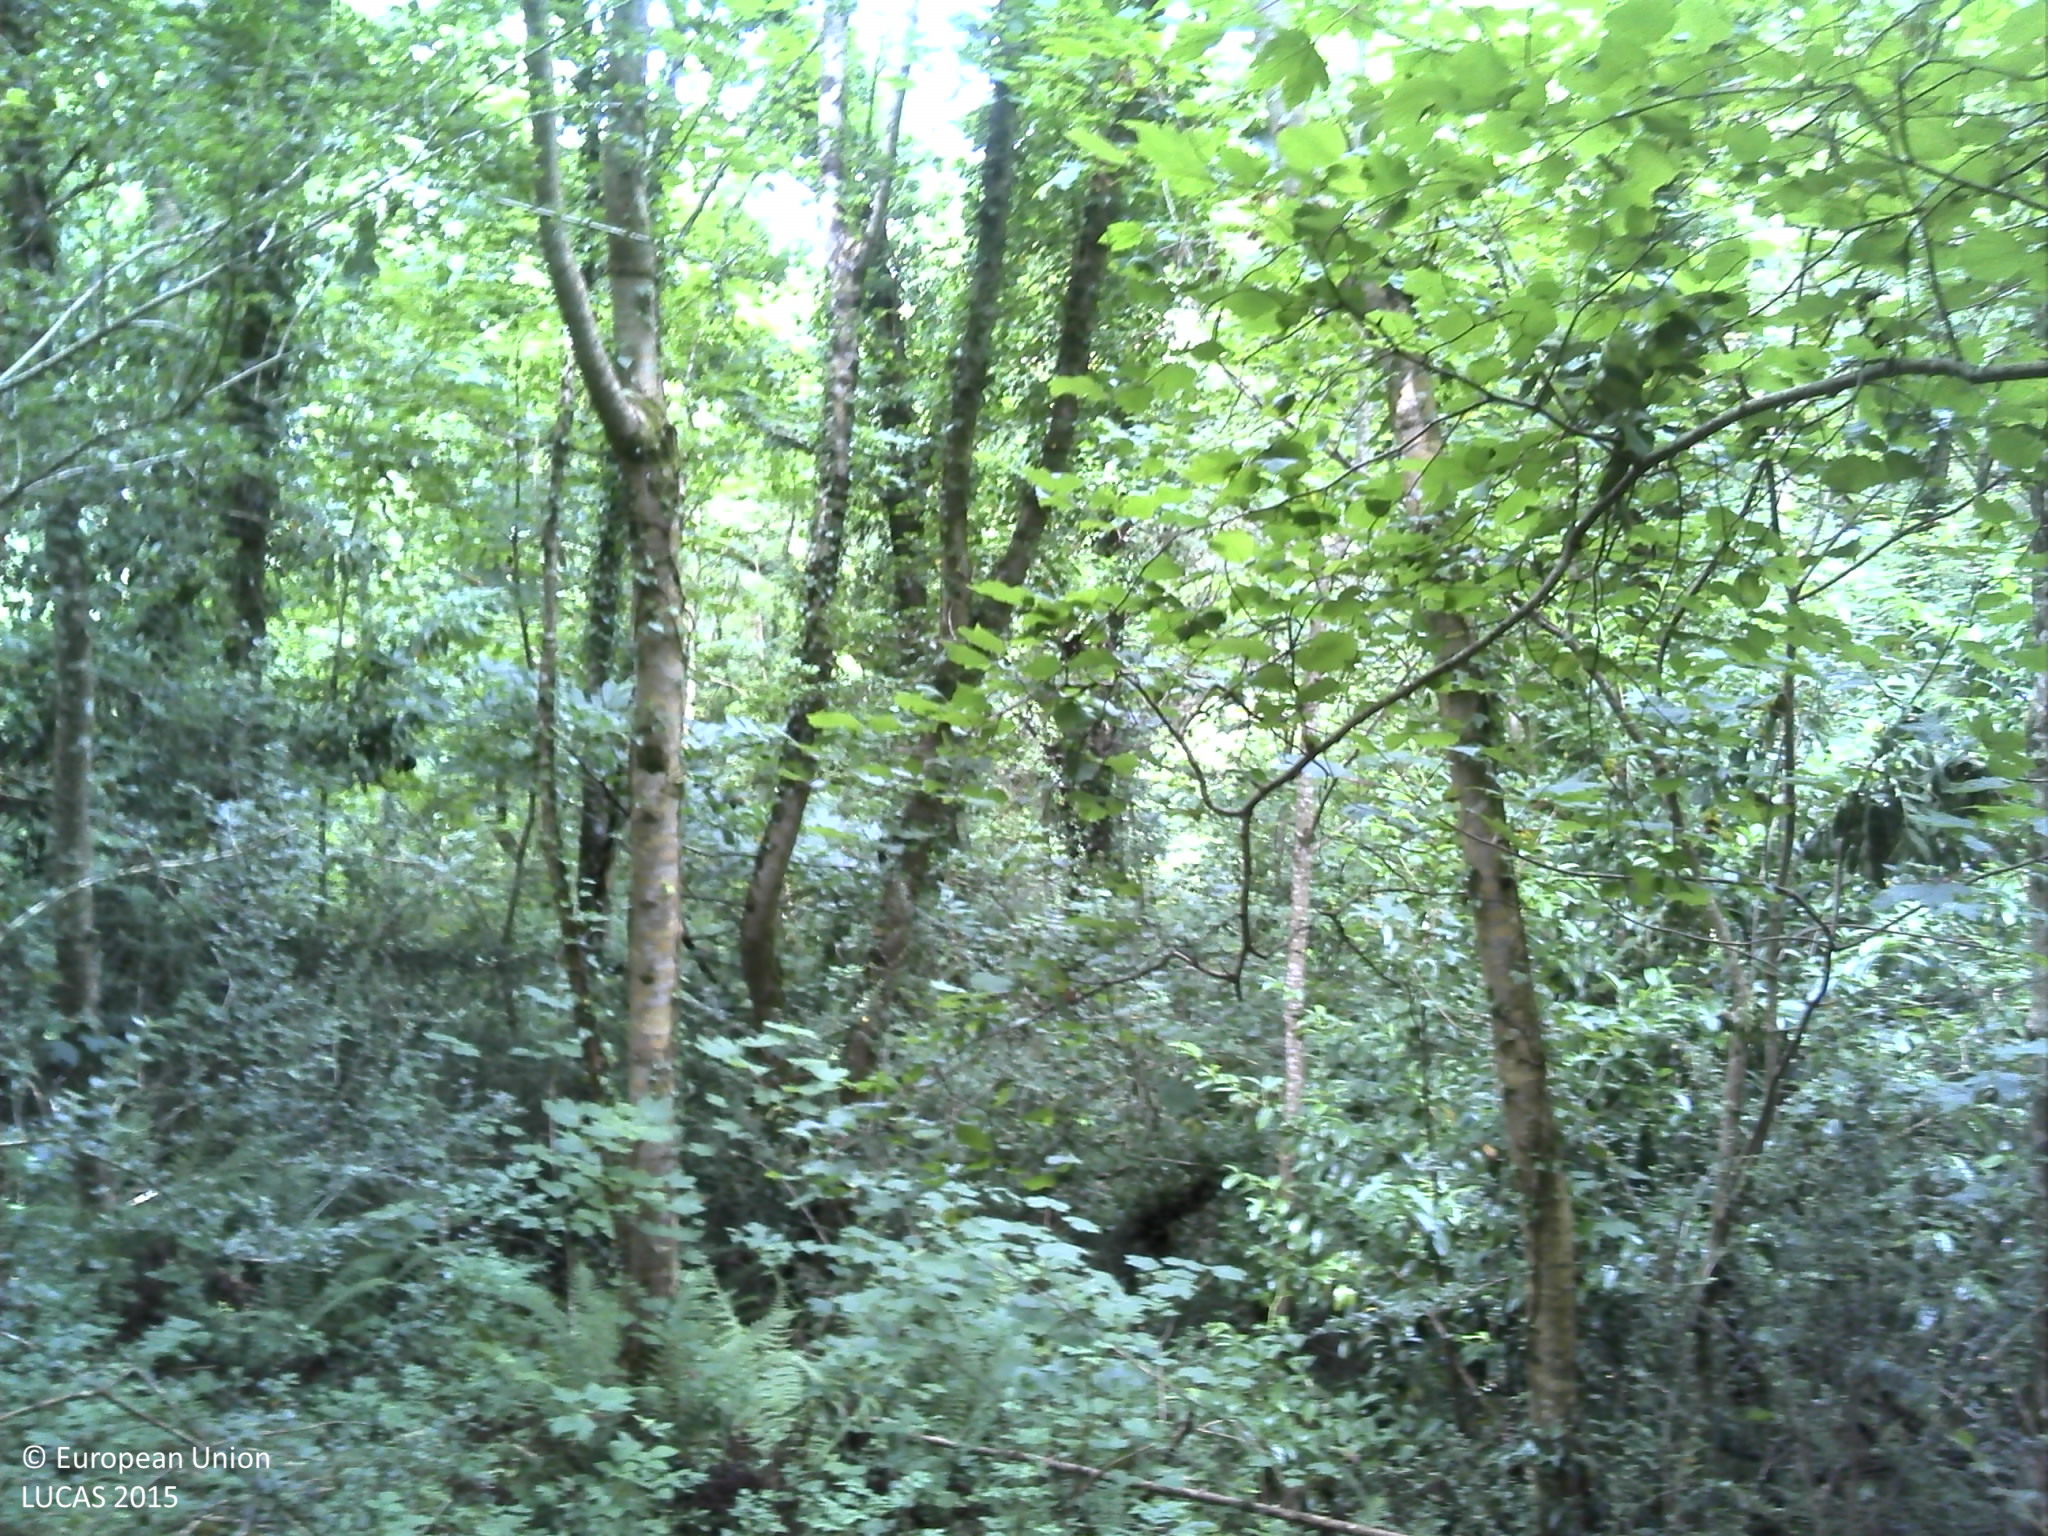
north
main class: Woodland
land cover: Broadleaved woodland
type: mesophytic deciduous forest
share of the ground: > 75 %
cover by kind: broadleaved forest trees 90 %, coniferous forest trees 5 %, shrubs 5 %
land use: Forestry
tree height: > 5 m
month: July
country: FR
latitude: 48.2777
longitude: -4.2550
